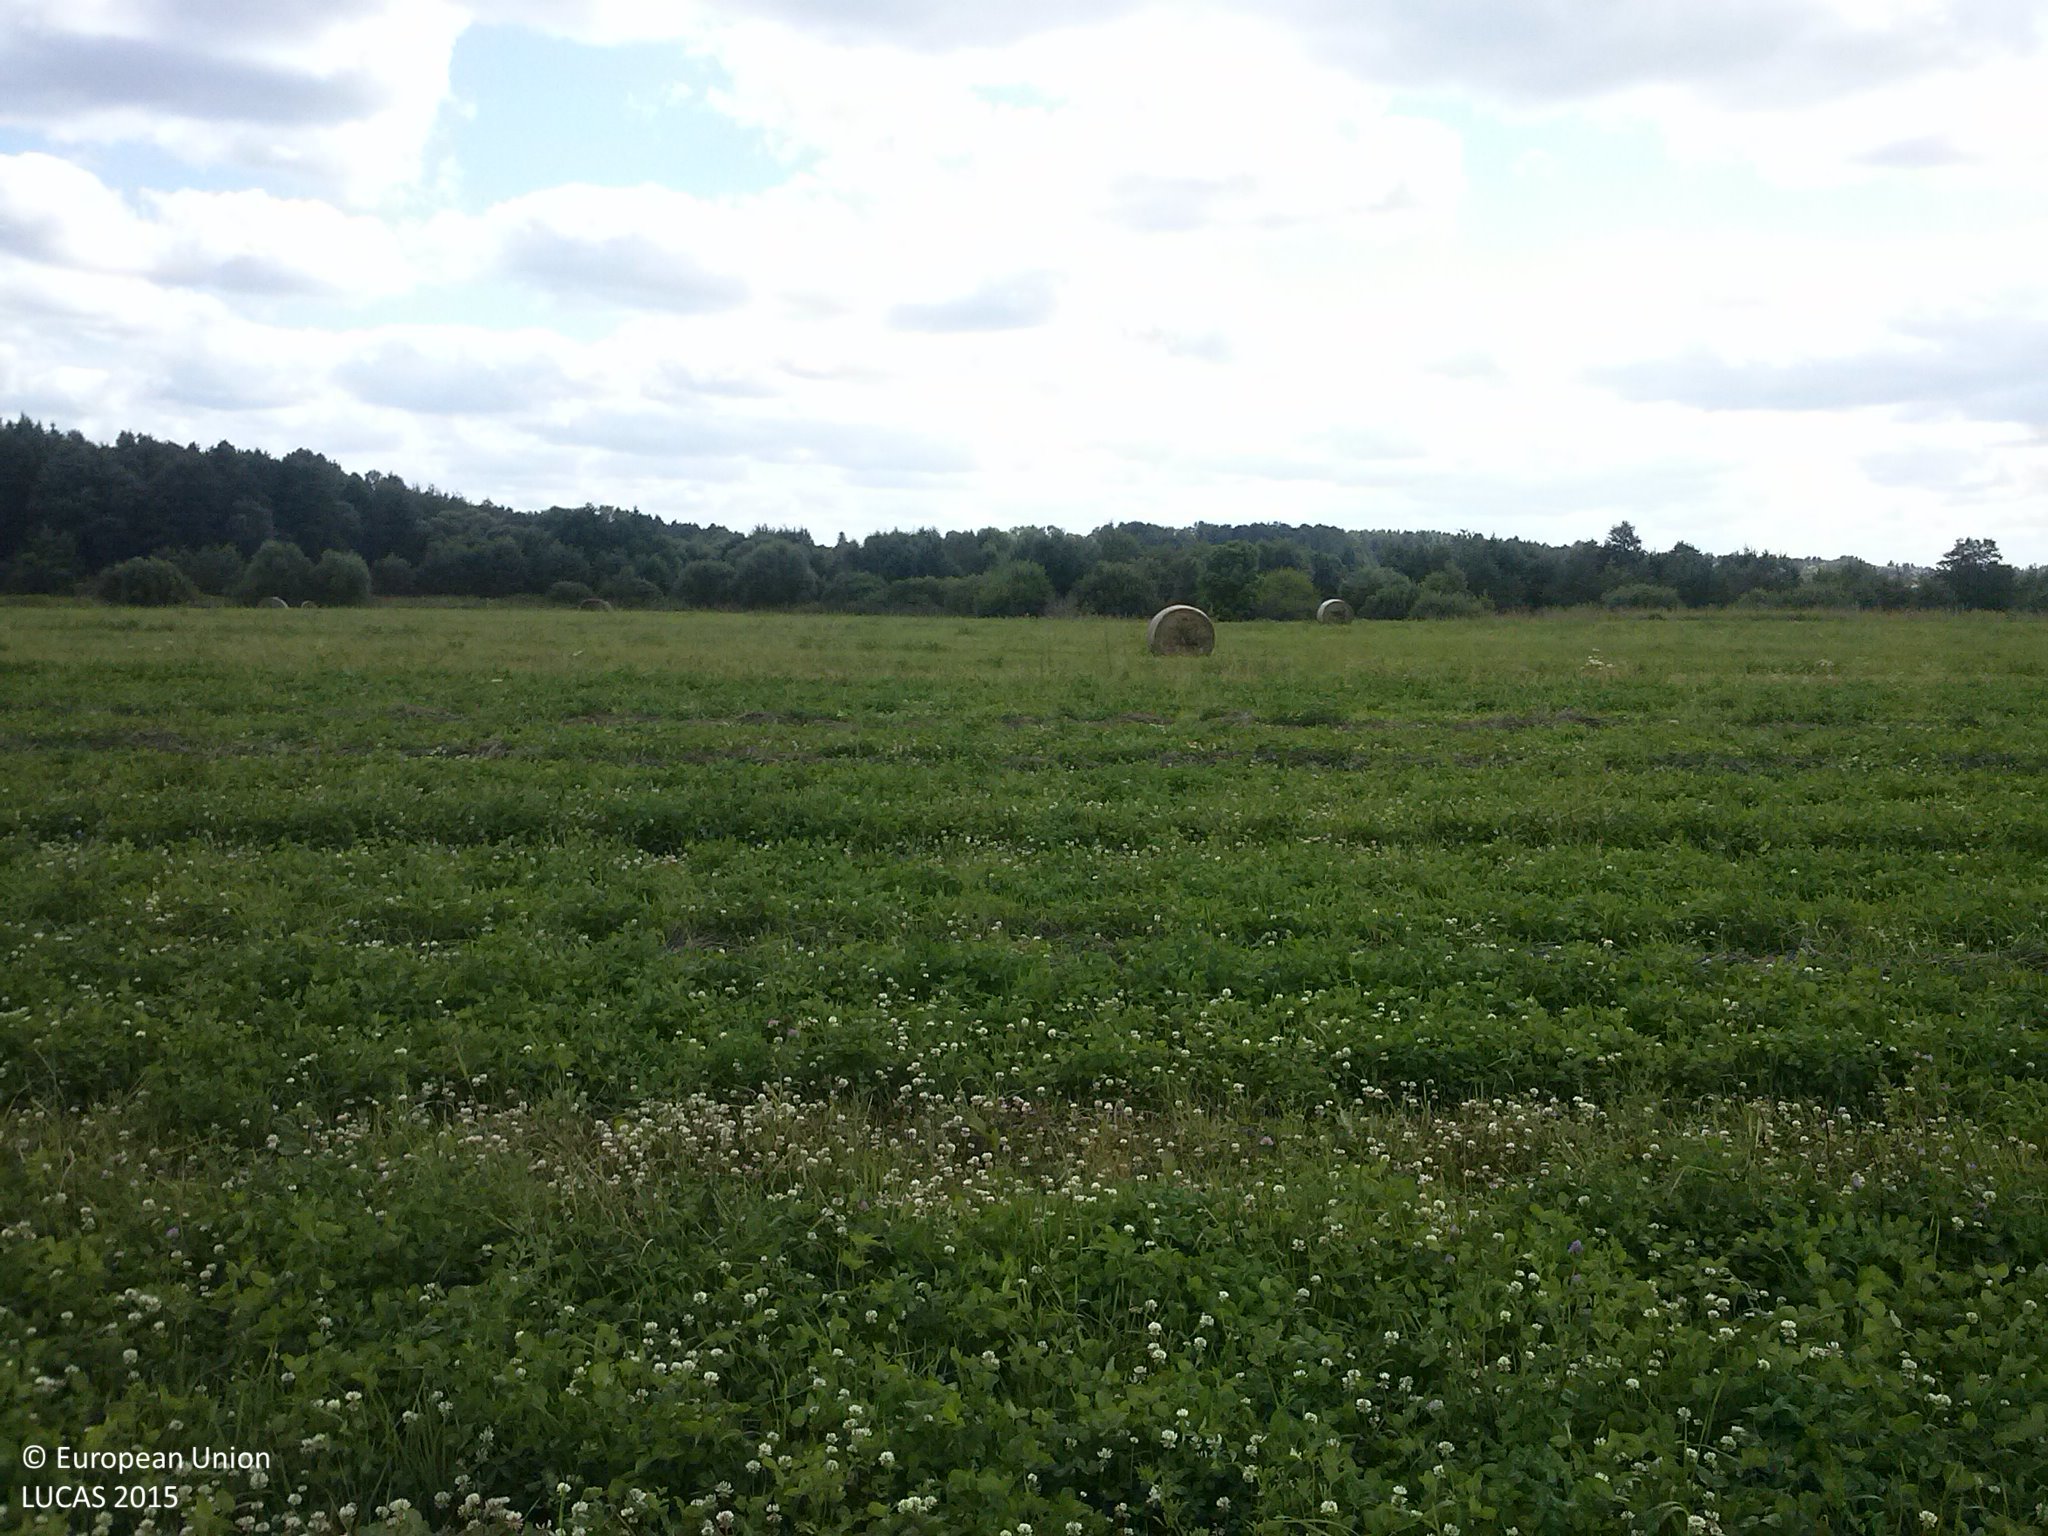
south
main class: Grassland
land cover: Grassland without tree/shrub cover
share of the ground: > 75 %
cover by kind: herbaceous plants 100 %
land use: Agriculture (excluding fallow land and kitchen gardens)
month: July
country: LV
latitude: 56.5129
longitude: 27.0157
